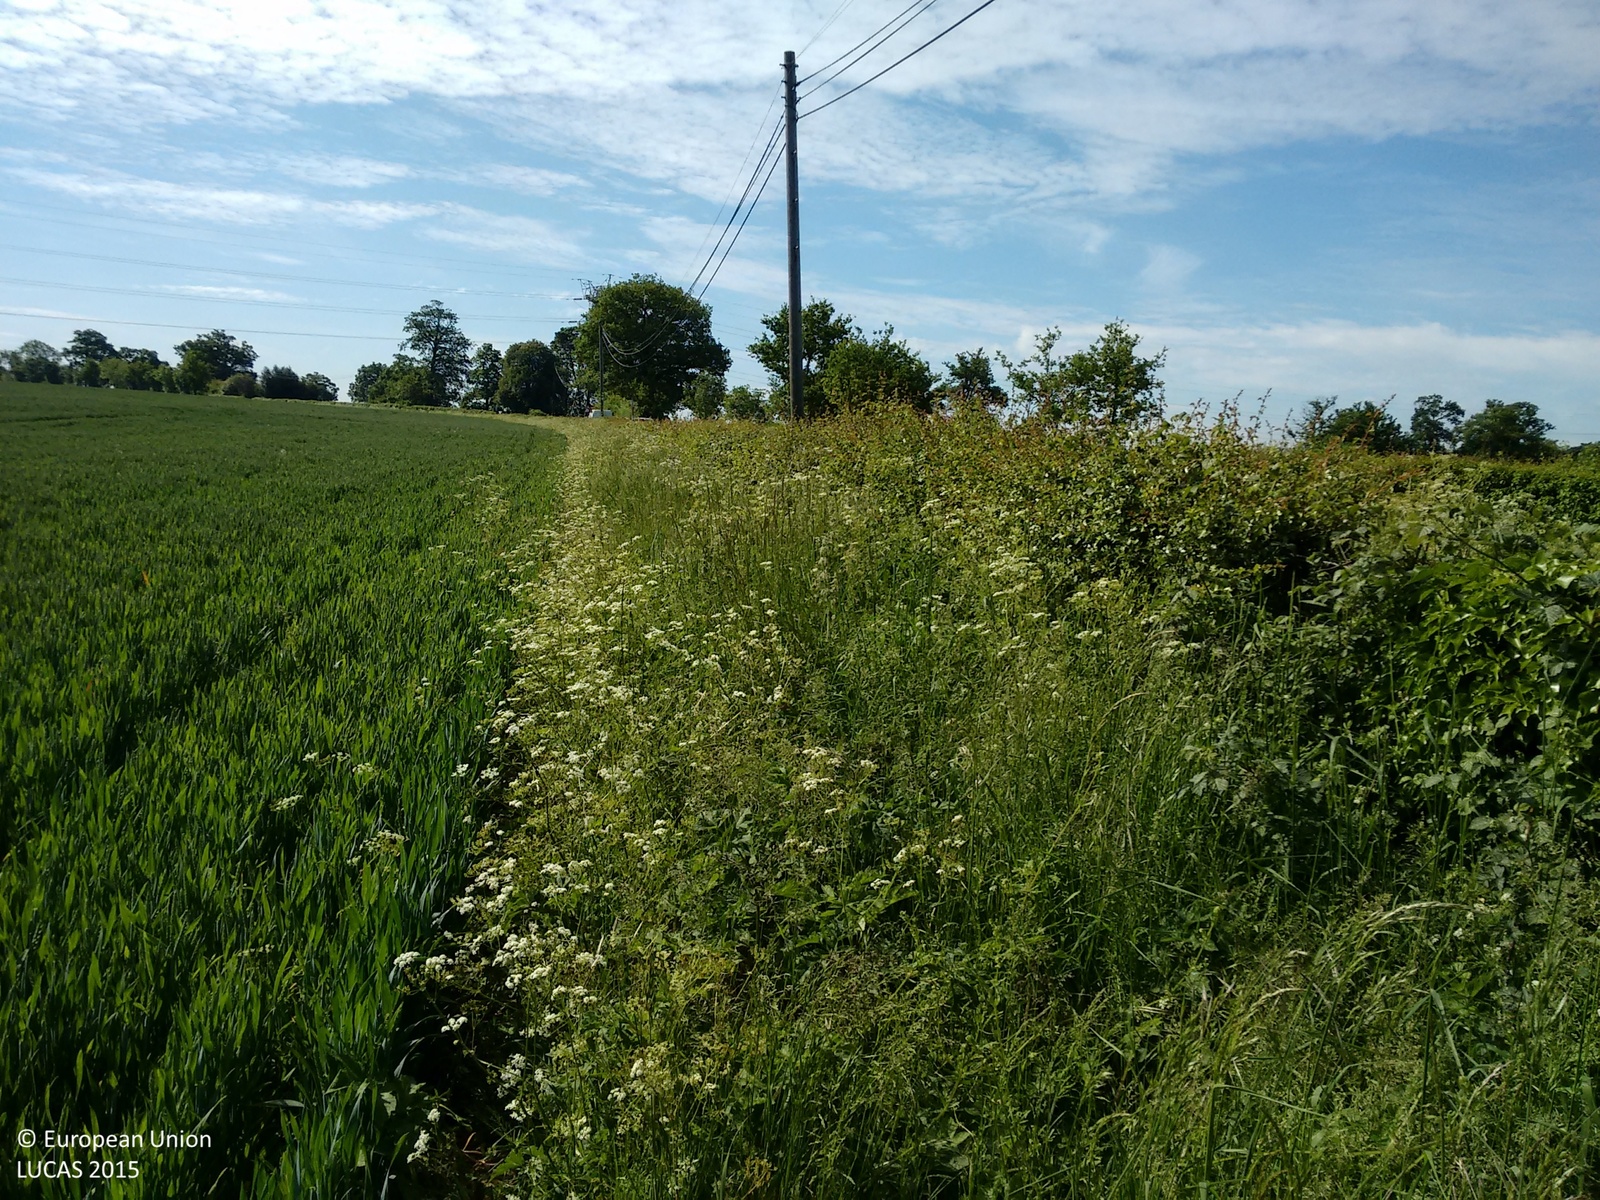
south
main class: Cropland
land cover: Common wheat
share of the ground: > 75 %
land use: Agriculture (excluding fallow land and kitchen gardens)
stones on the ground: < 10 %
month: June
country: GB
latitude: 51.7338
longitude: -0.2438
